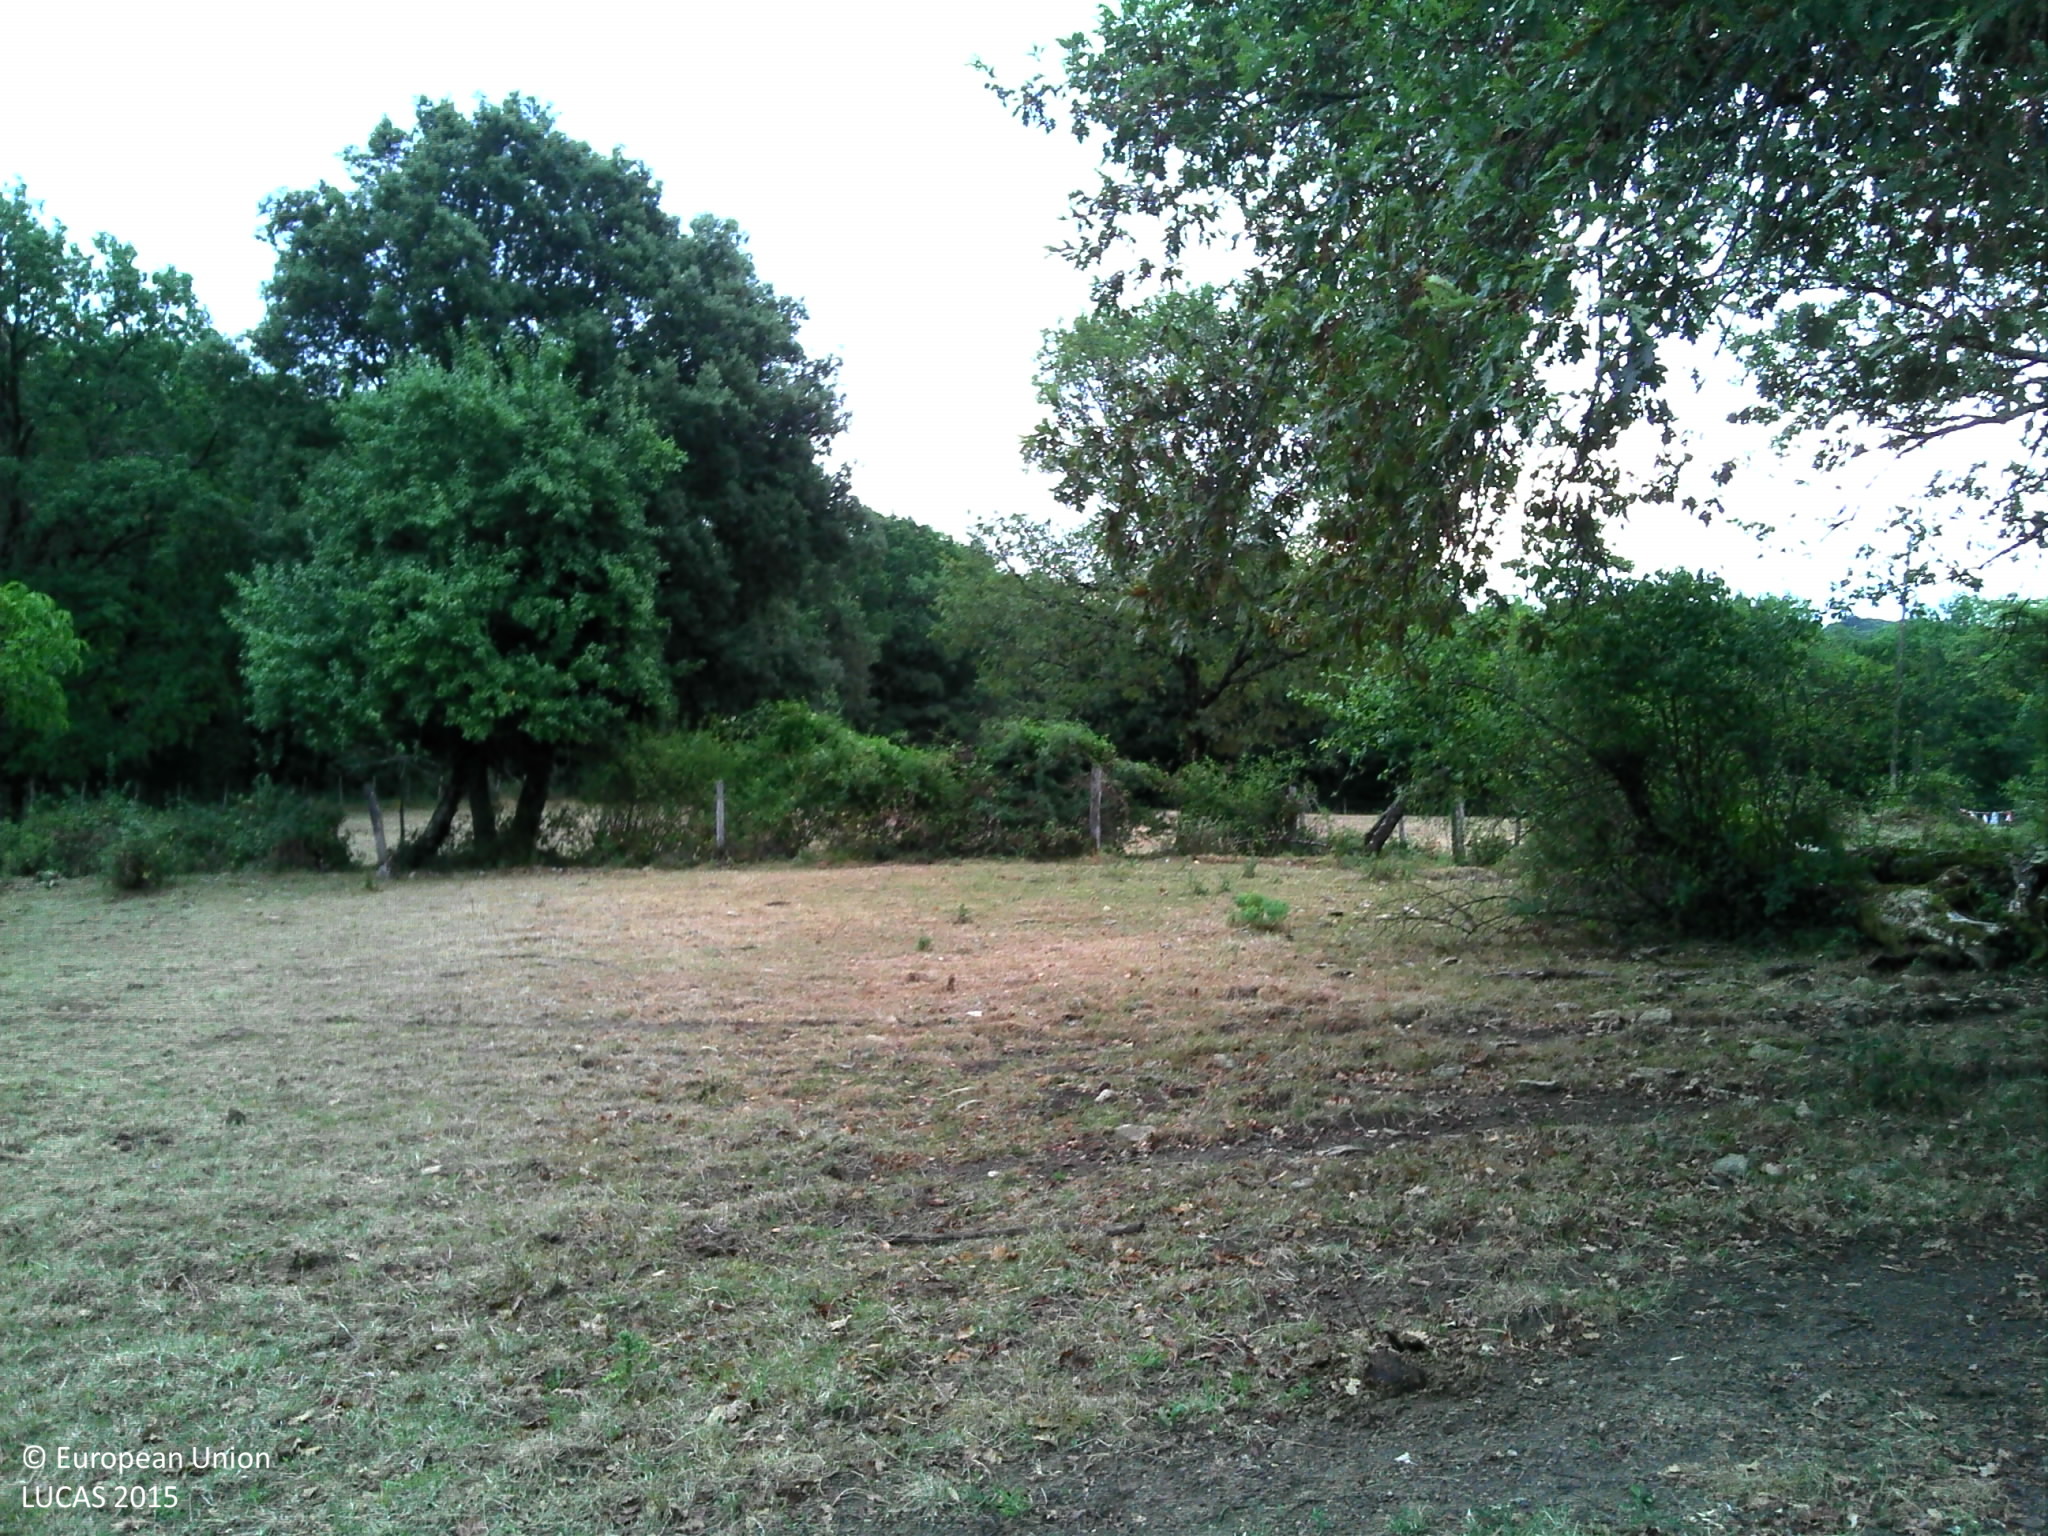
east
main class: Grassland
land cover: Grassland without tree/shrub cover
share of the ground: > 75 %
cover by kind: herbaceous plants 95 %, lichens and mosses 5 %
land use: Agriculture (excluding fallow land and kitchen gardens)
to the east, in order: Grassland without tree/shrub cover; Fences; Managed hedges; Tracks; Grassland without tree/shrub cover; Electric lines; Grassland without tree/shrub cover; Fences; Broadleaved woodland; Fences; Broadleaved woodland
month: July
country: FR
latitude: 44.9560
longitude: 1.2098
